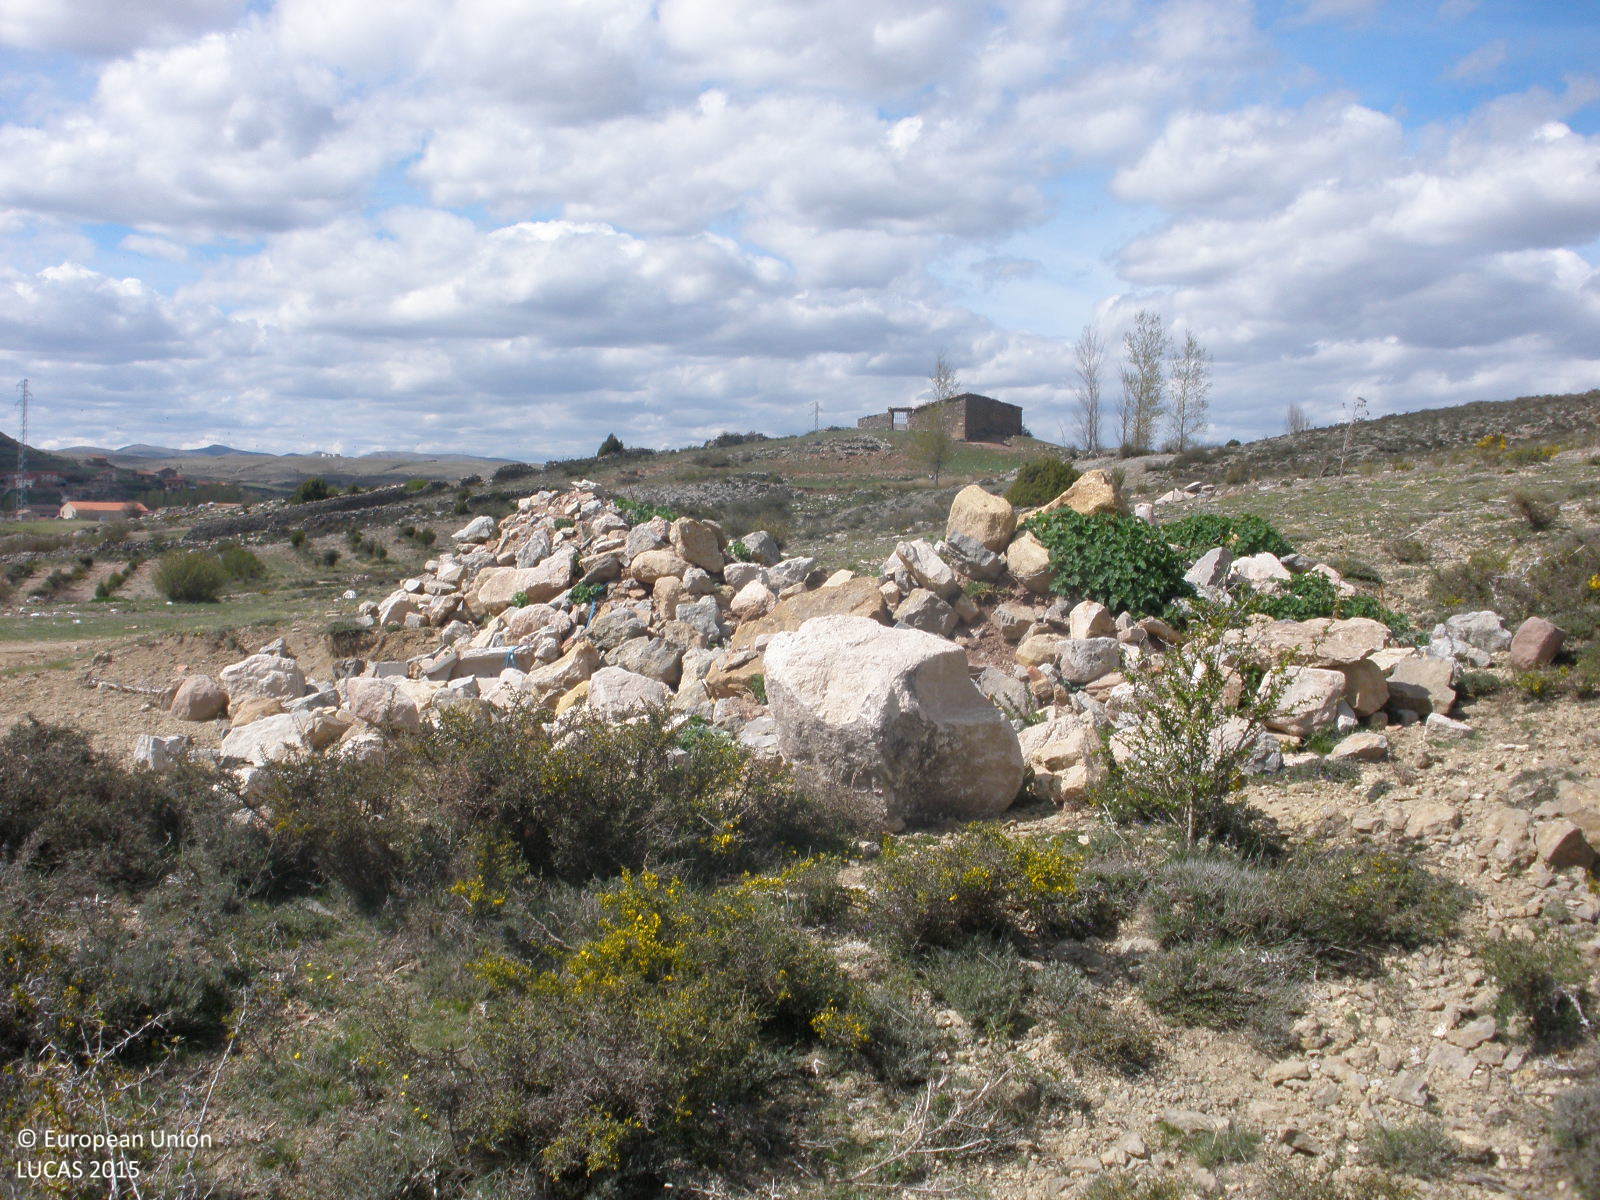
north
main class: Shrubland
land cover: Shrubland without tree cover
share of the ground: 50 - 75 %
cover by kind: shrubs 50 %, consolidated bare surface 30 %, herbaceous plants 20 %
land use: Agriculture (excluding fallow land and kitchen gardens)
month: April
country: ES
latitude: 40.4305
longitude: -0.8426
